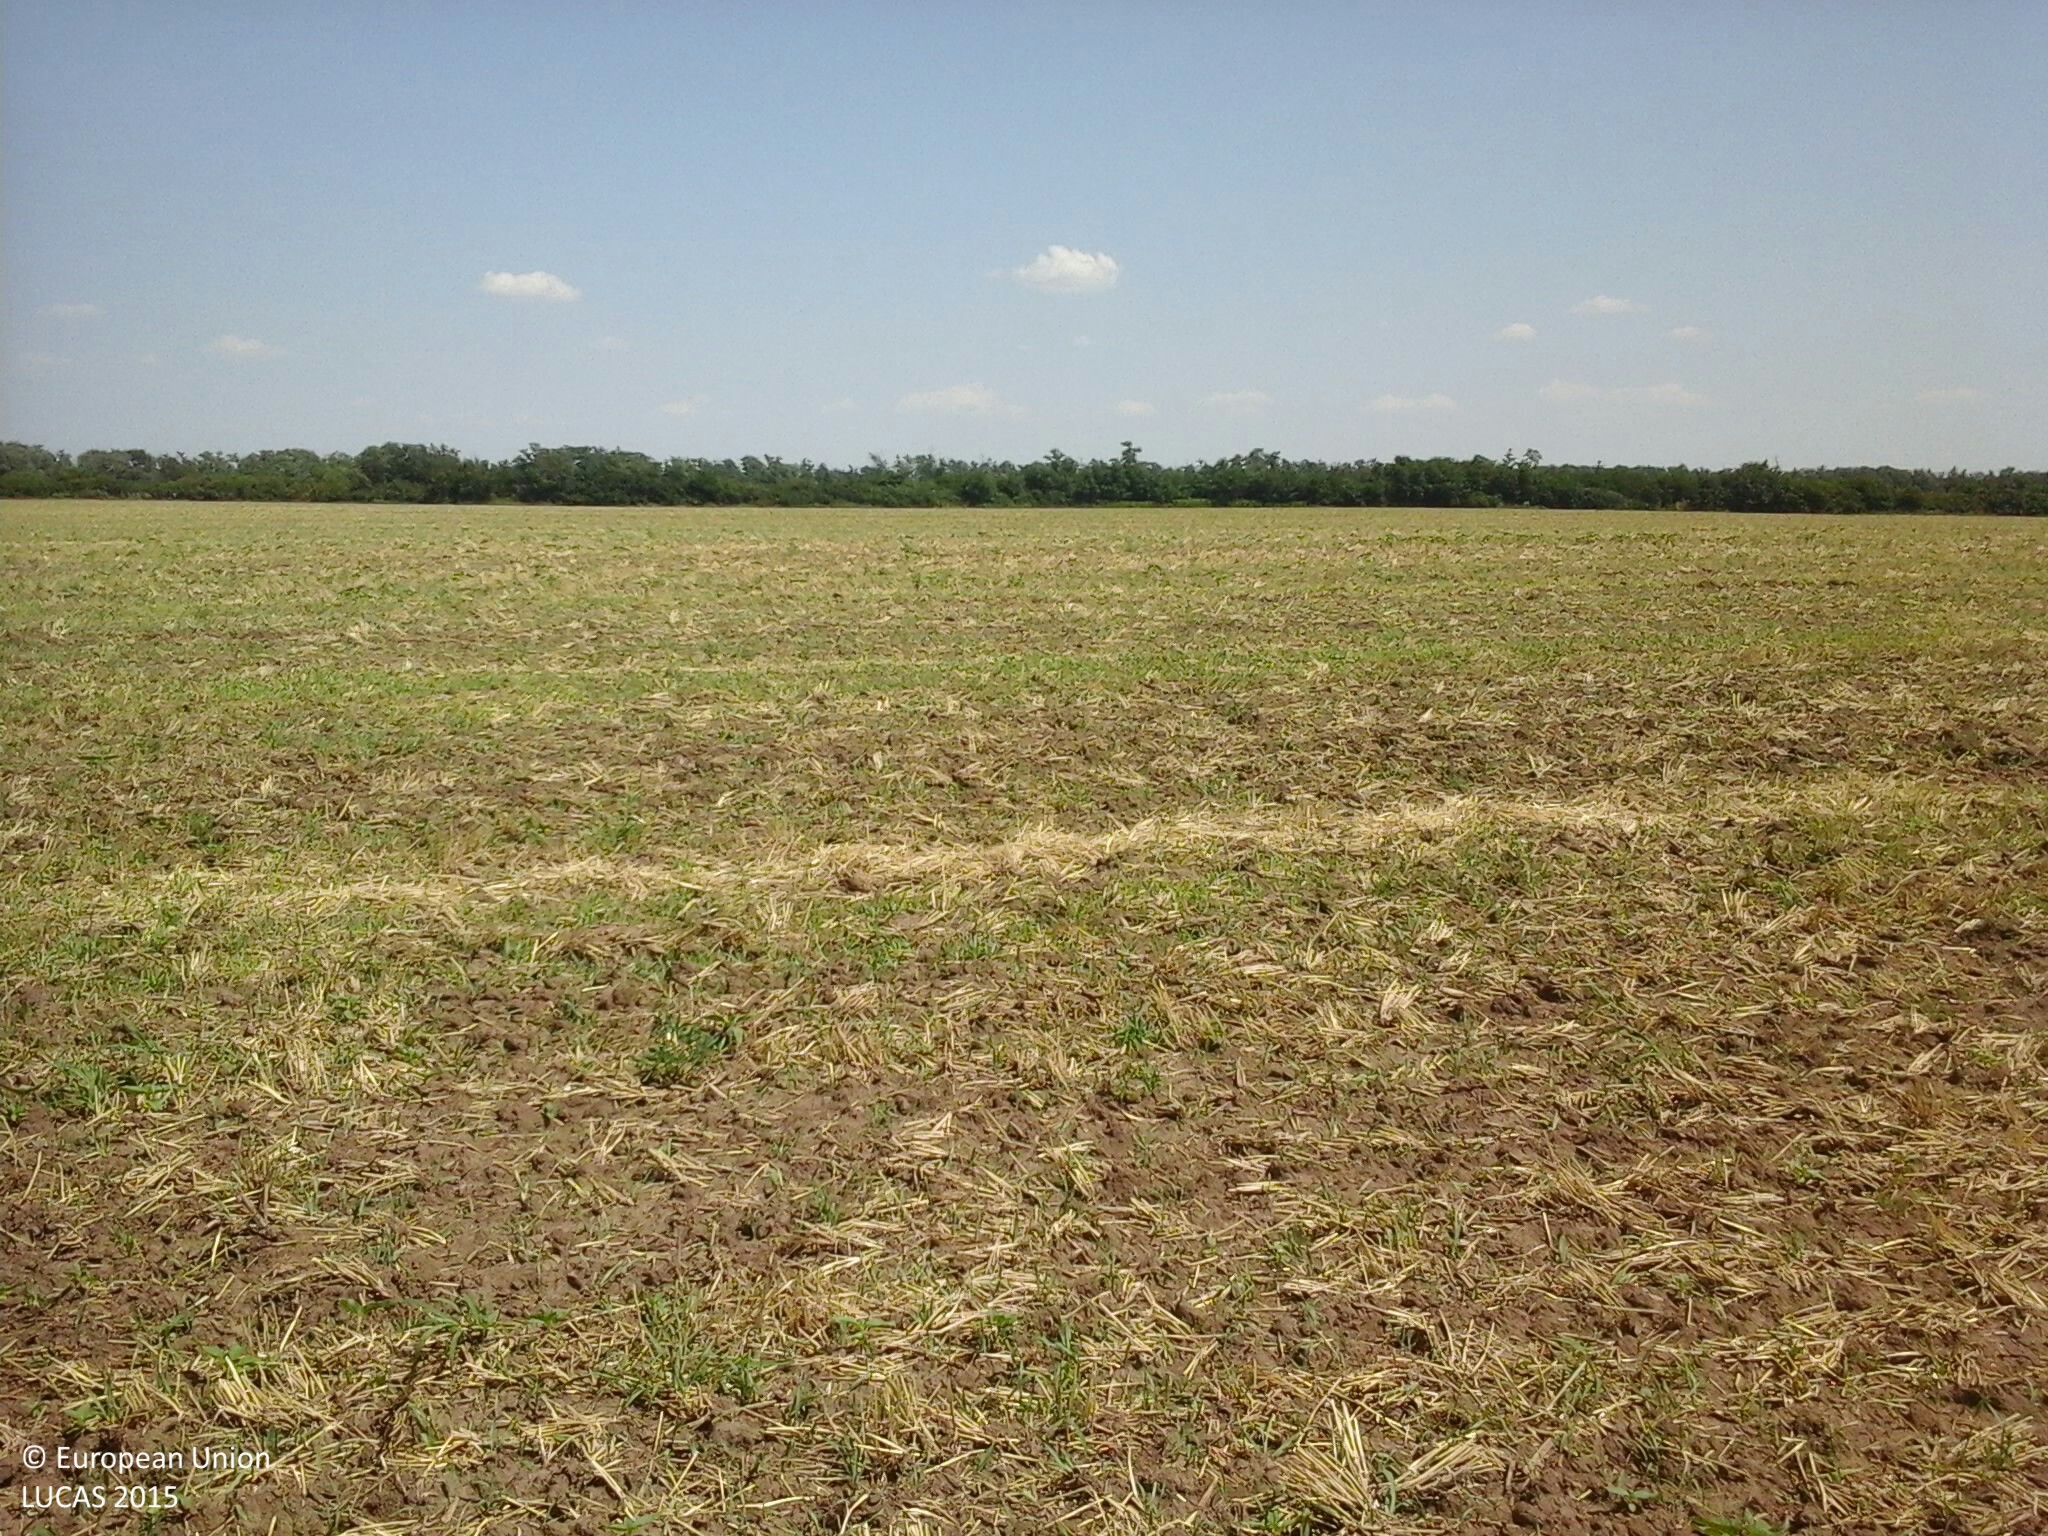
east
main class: Cropland
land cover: Common wheat
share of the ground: < 10 %
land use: Agriculture (excluding fallow land and kitchen gardens)
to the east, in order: Common wheat
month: July
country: HU
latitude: 47.0823
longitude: 18.2429
